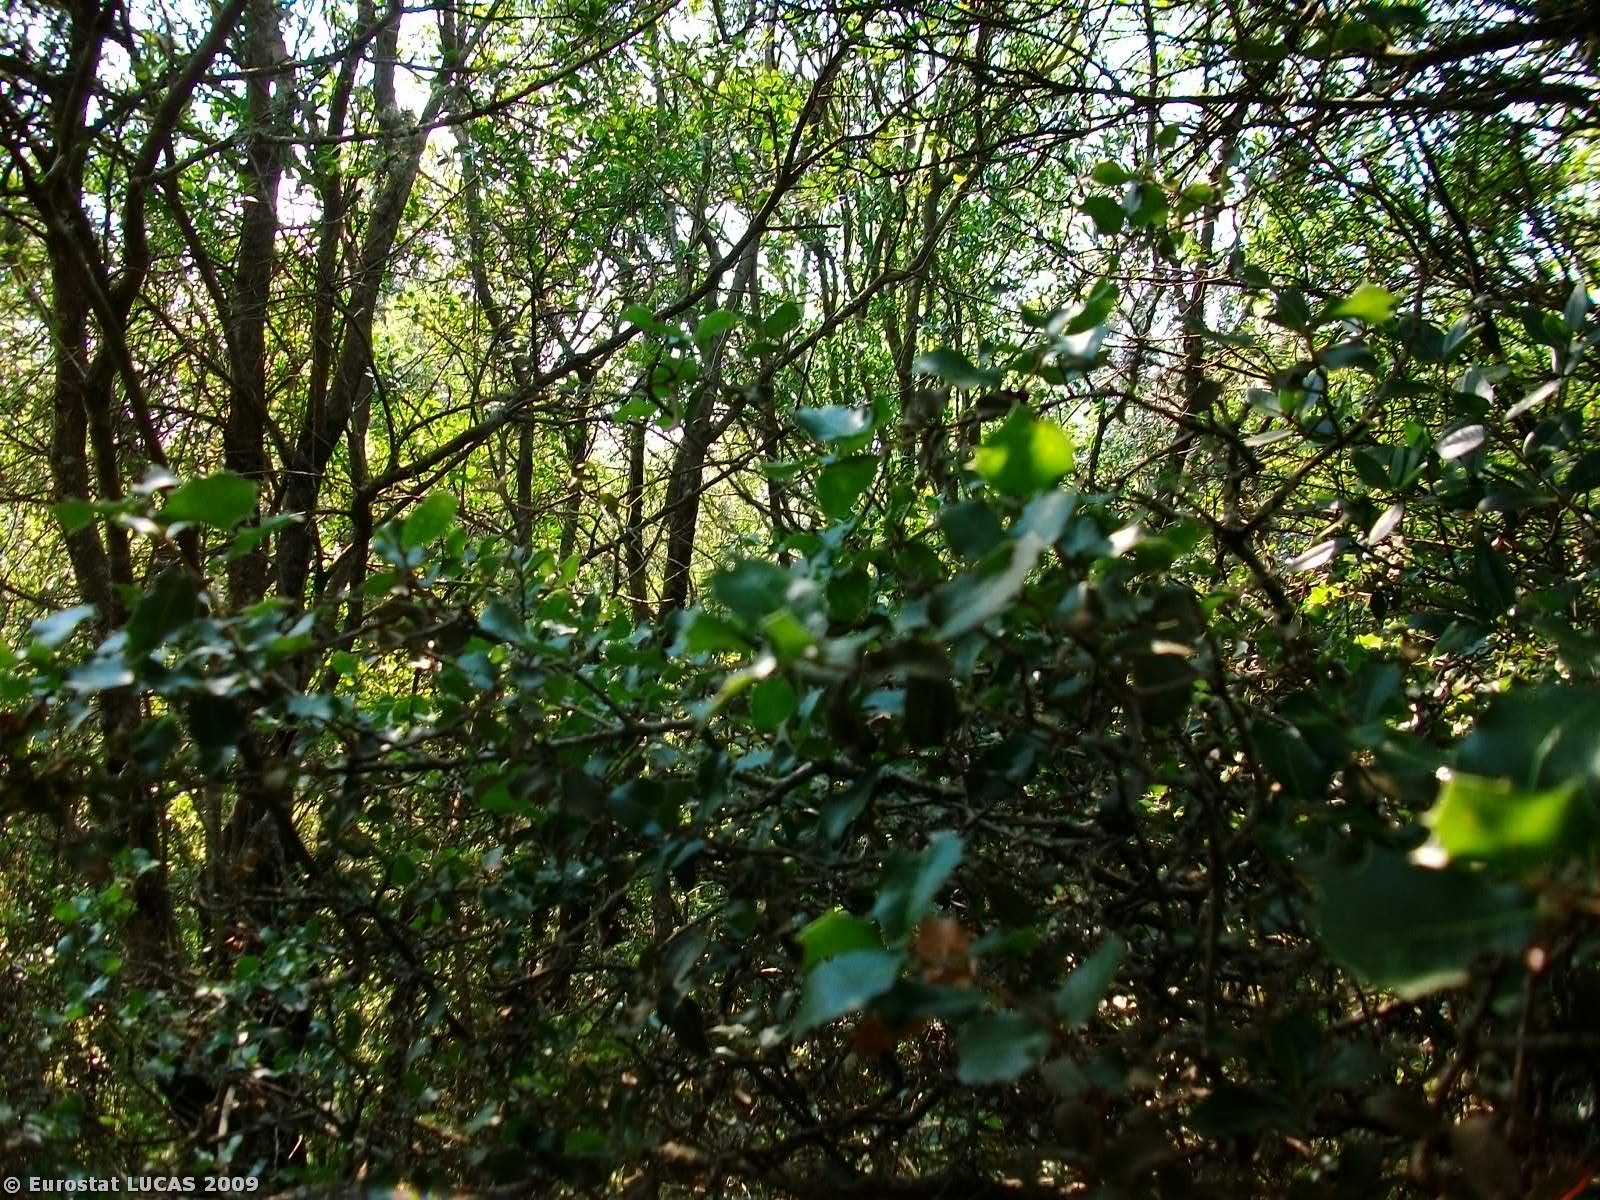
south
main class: Woodland
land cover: Broadleaved woodland
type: mesophytic deciduous forest
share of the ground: > 75 %
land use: Forestry
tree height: > 5 m
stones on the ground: 10 - 25 %
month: July
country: GR
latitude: 41.0560
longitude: 24.4904
